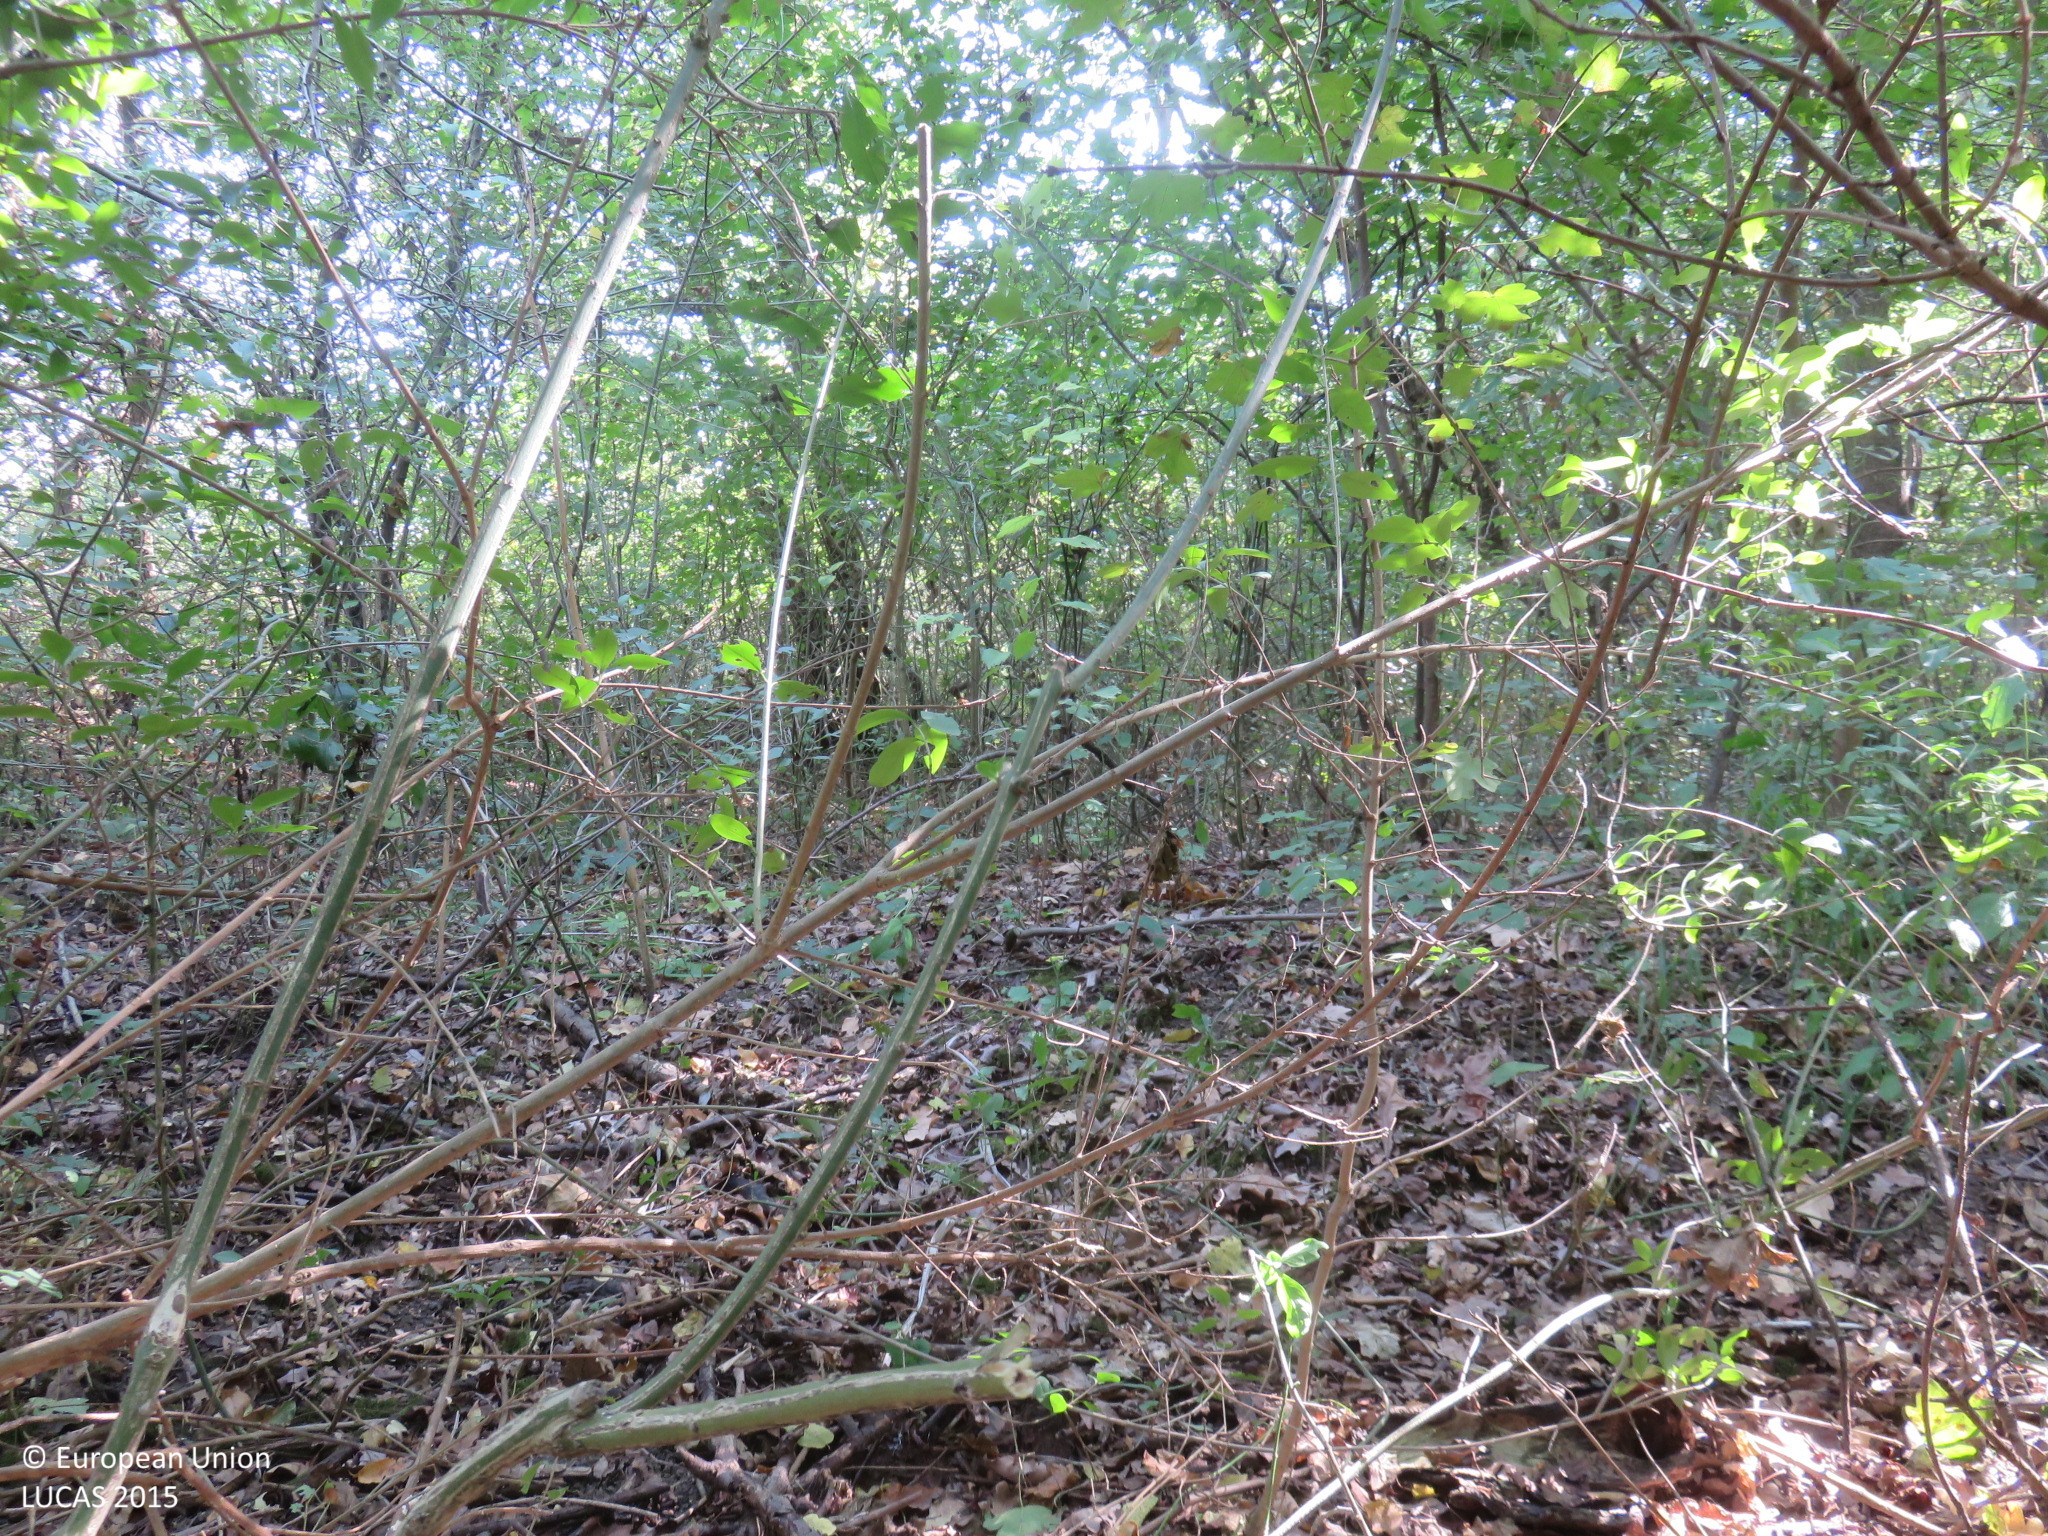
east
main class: Woodland
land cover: Broadleaved woodland
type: mesophytic deciduous forest
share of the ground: > 75 %
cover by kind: broadleaved forest trees 95 %, shrubs 5 %
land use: Forestry
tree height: < 5 m
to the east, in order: Broadleaved woodland; Shrubland without tree cover; Lucerne
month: September
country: BG
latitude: 43.4952
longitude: 24.9722
